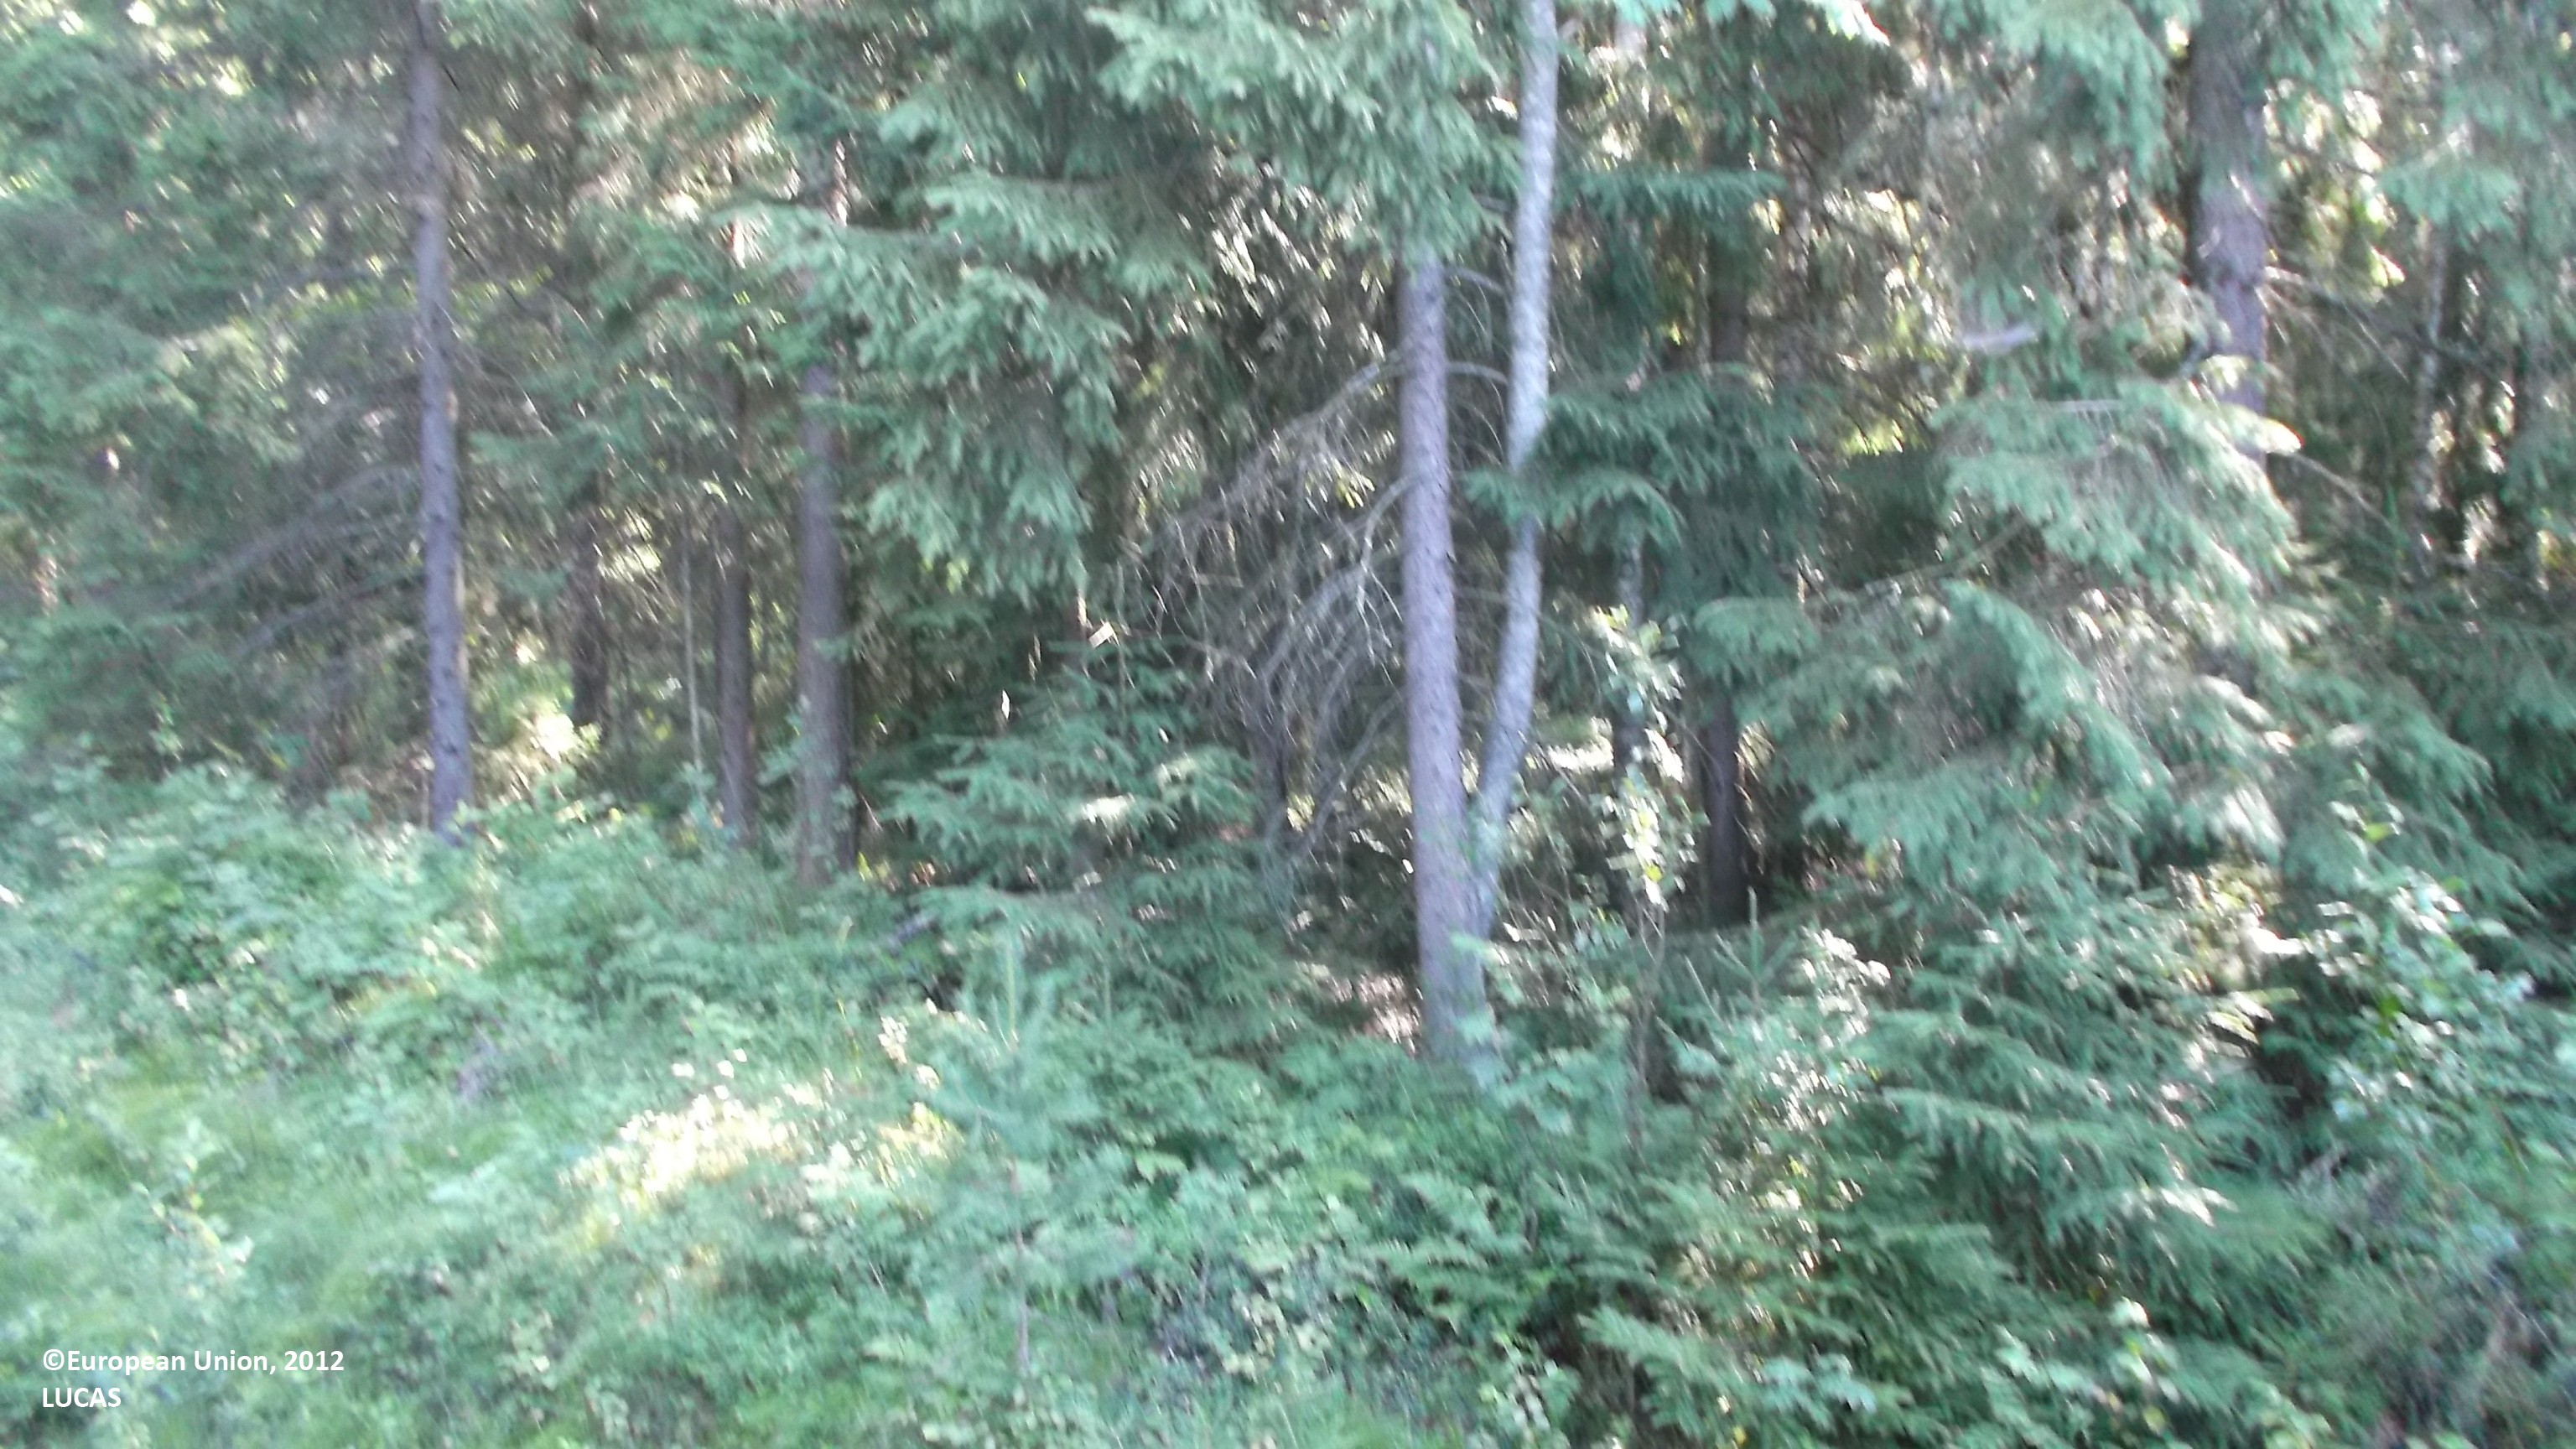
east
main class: Woodland
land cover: Spruce dominated mixed woodland
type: boreal forest
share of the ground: 50 - 75 %
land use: Forestry
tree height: > 5 m
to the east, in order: Spruce dominated mixed woodland; Ditches and canals; Spruce dominated mixed woodland; Ditches and canals; Spruce dominated coniferous woodland; Ditches and canals; Spruce dominated coniferous woodland
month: July
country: FI
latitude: 63.6445
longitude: 22.9535
